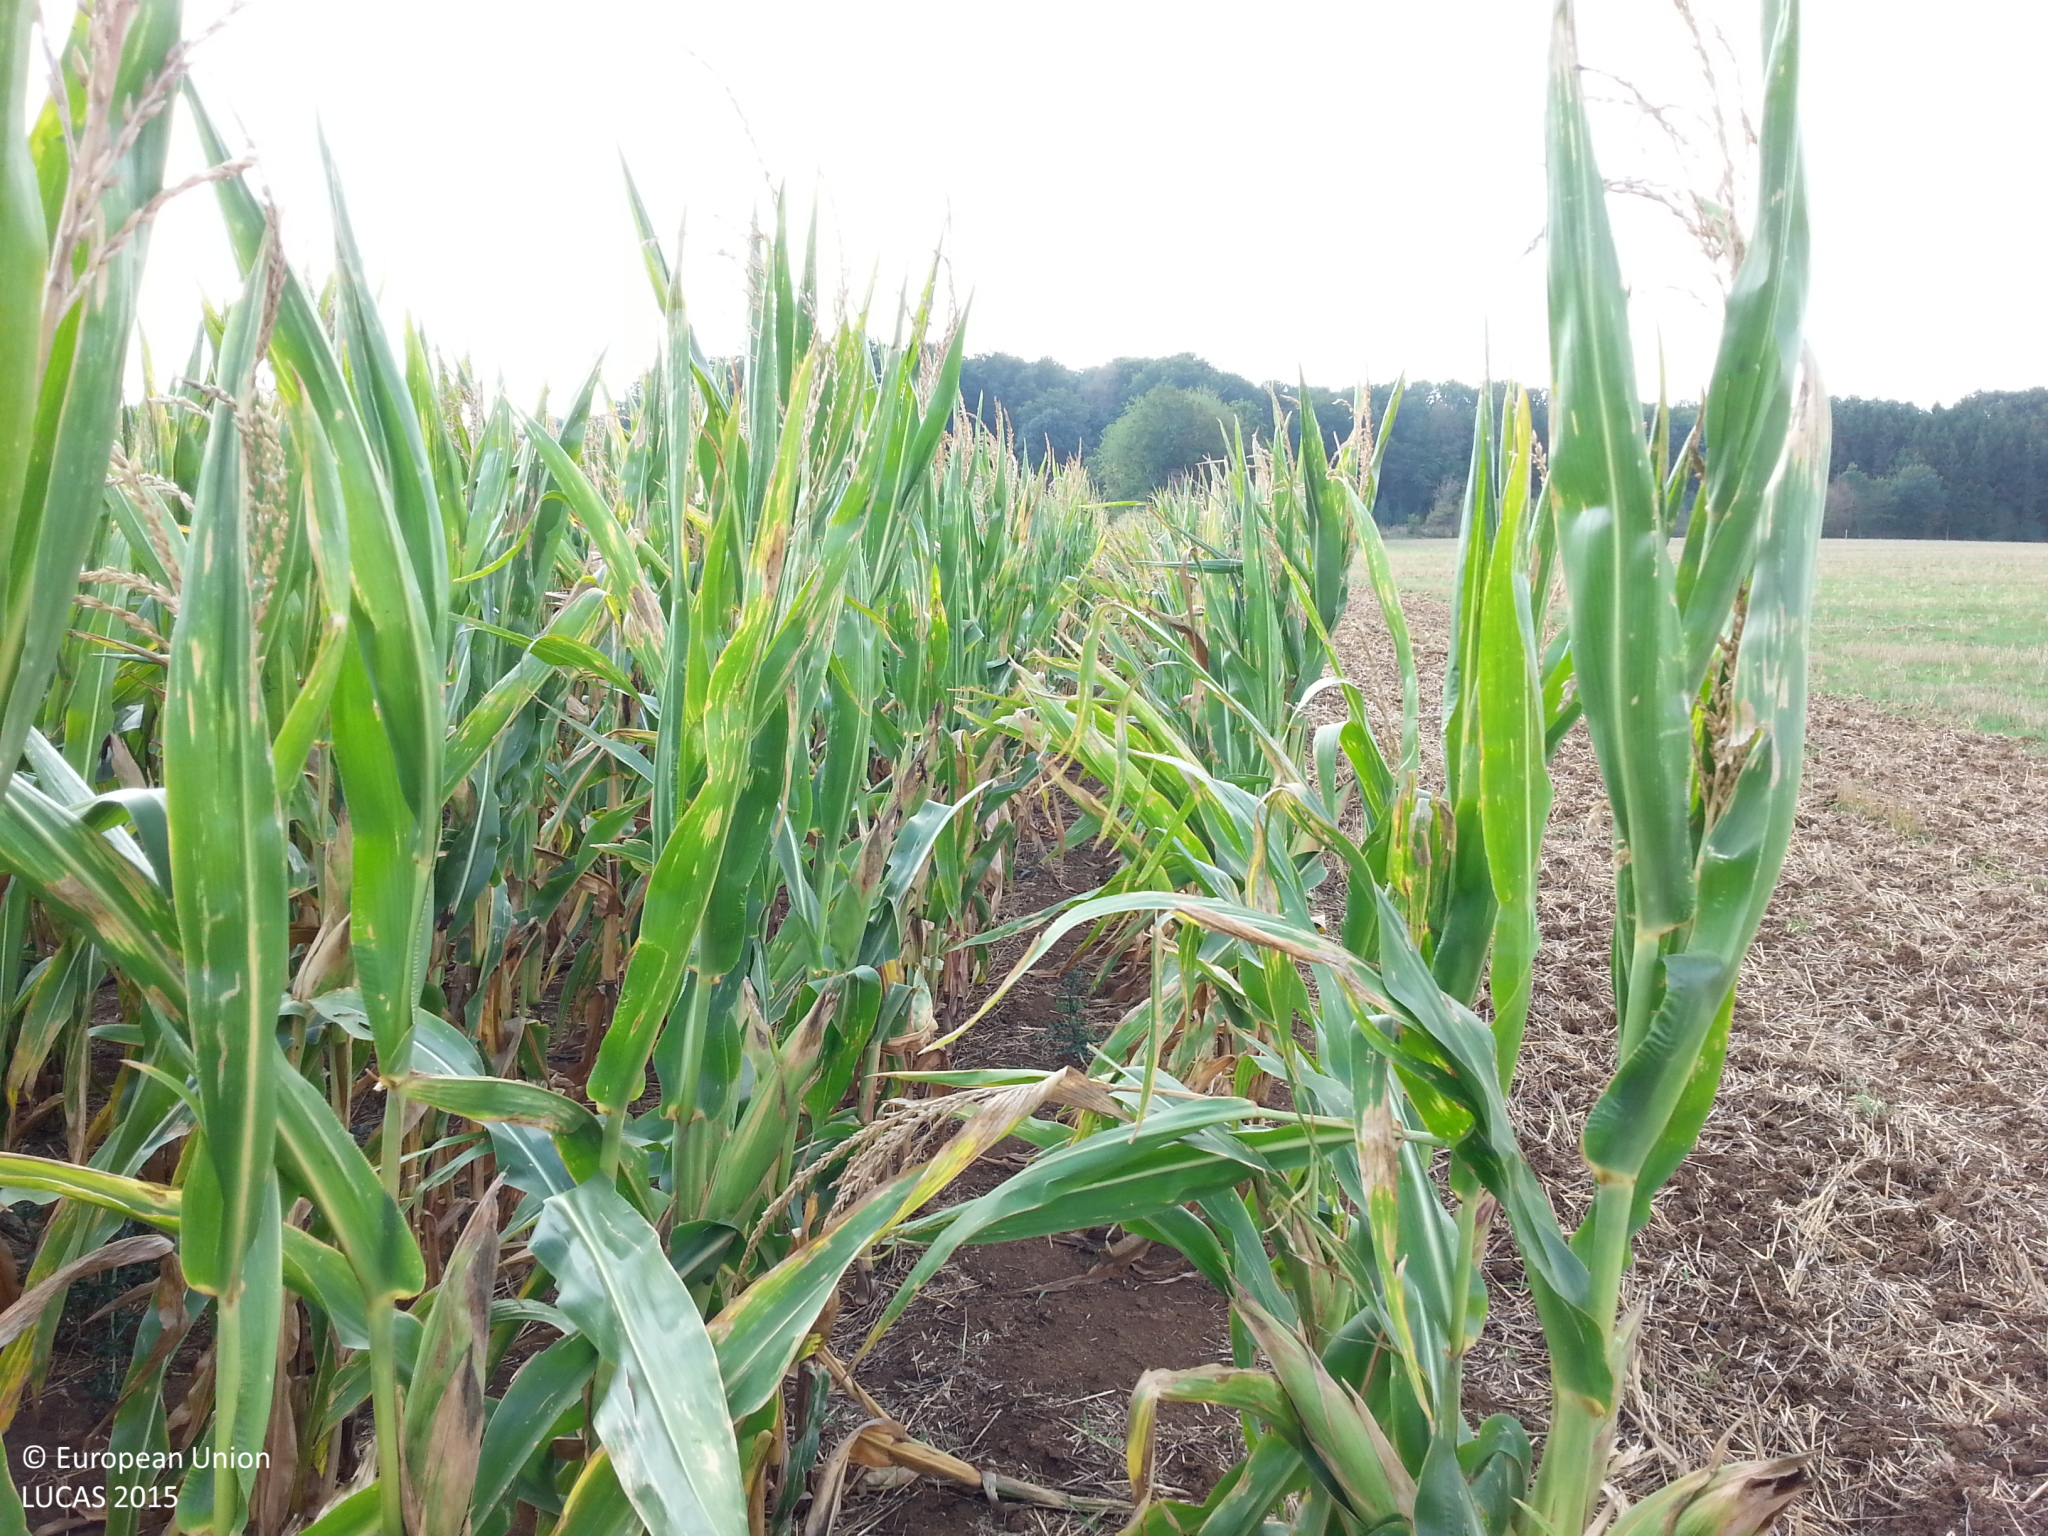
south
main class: Cropland
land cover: Maize
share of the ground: > 75 %
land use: Agriculture (excluding fallow land and kitchen gardens)
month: September
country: DE
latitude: 49.3569
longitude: 9.9587
